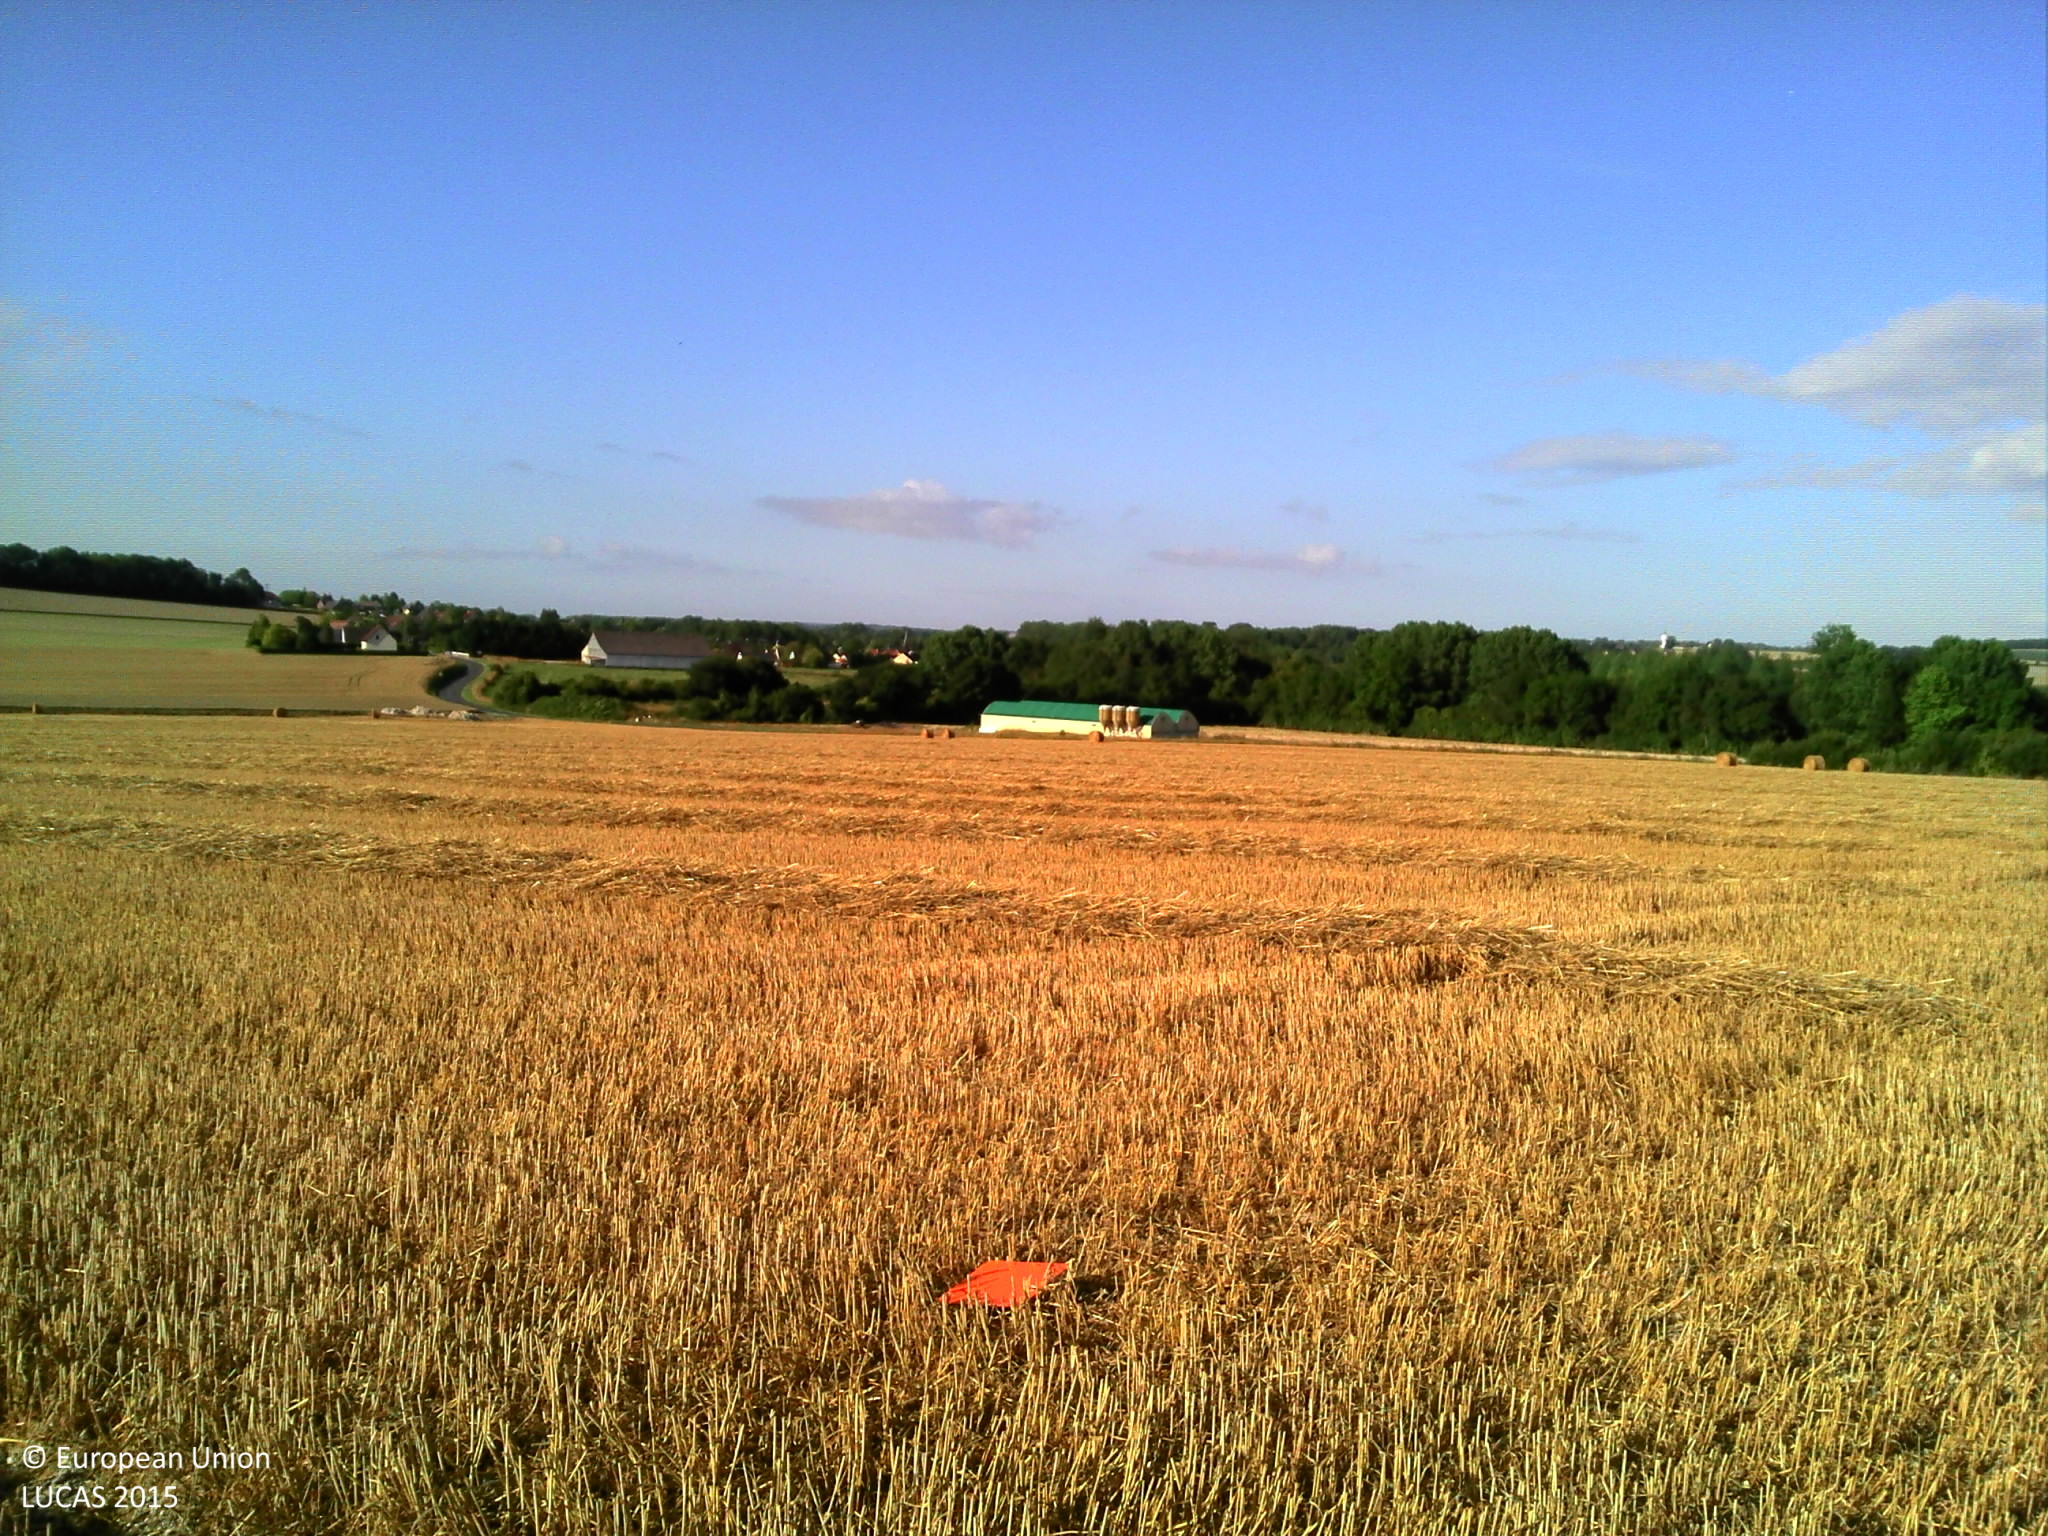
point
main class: Cropland
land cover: Common wheat
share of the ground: > 75 %
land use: Agriculture (excluding fallow land and kitchen gardens)
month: July
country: FR
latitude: 49.9516
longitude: 2.4474
